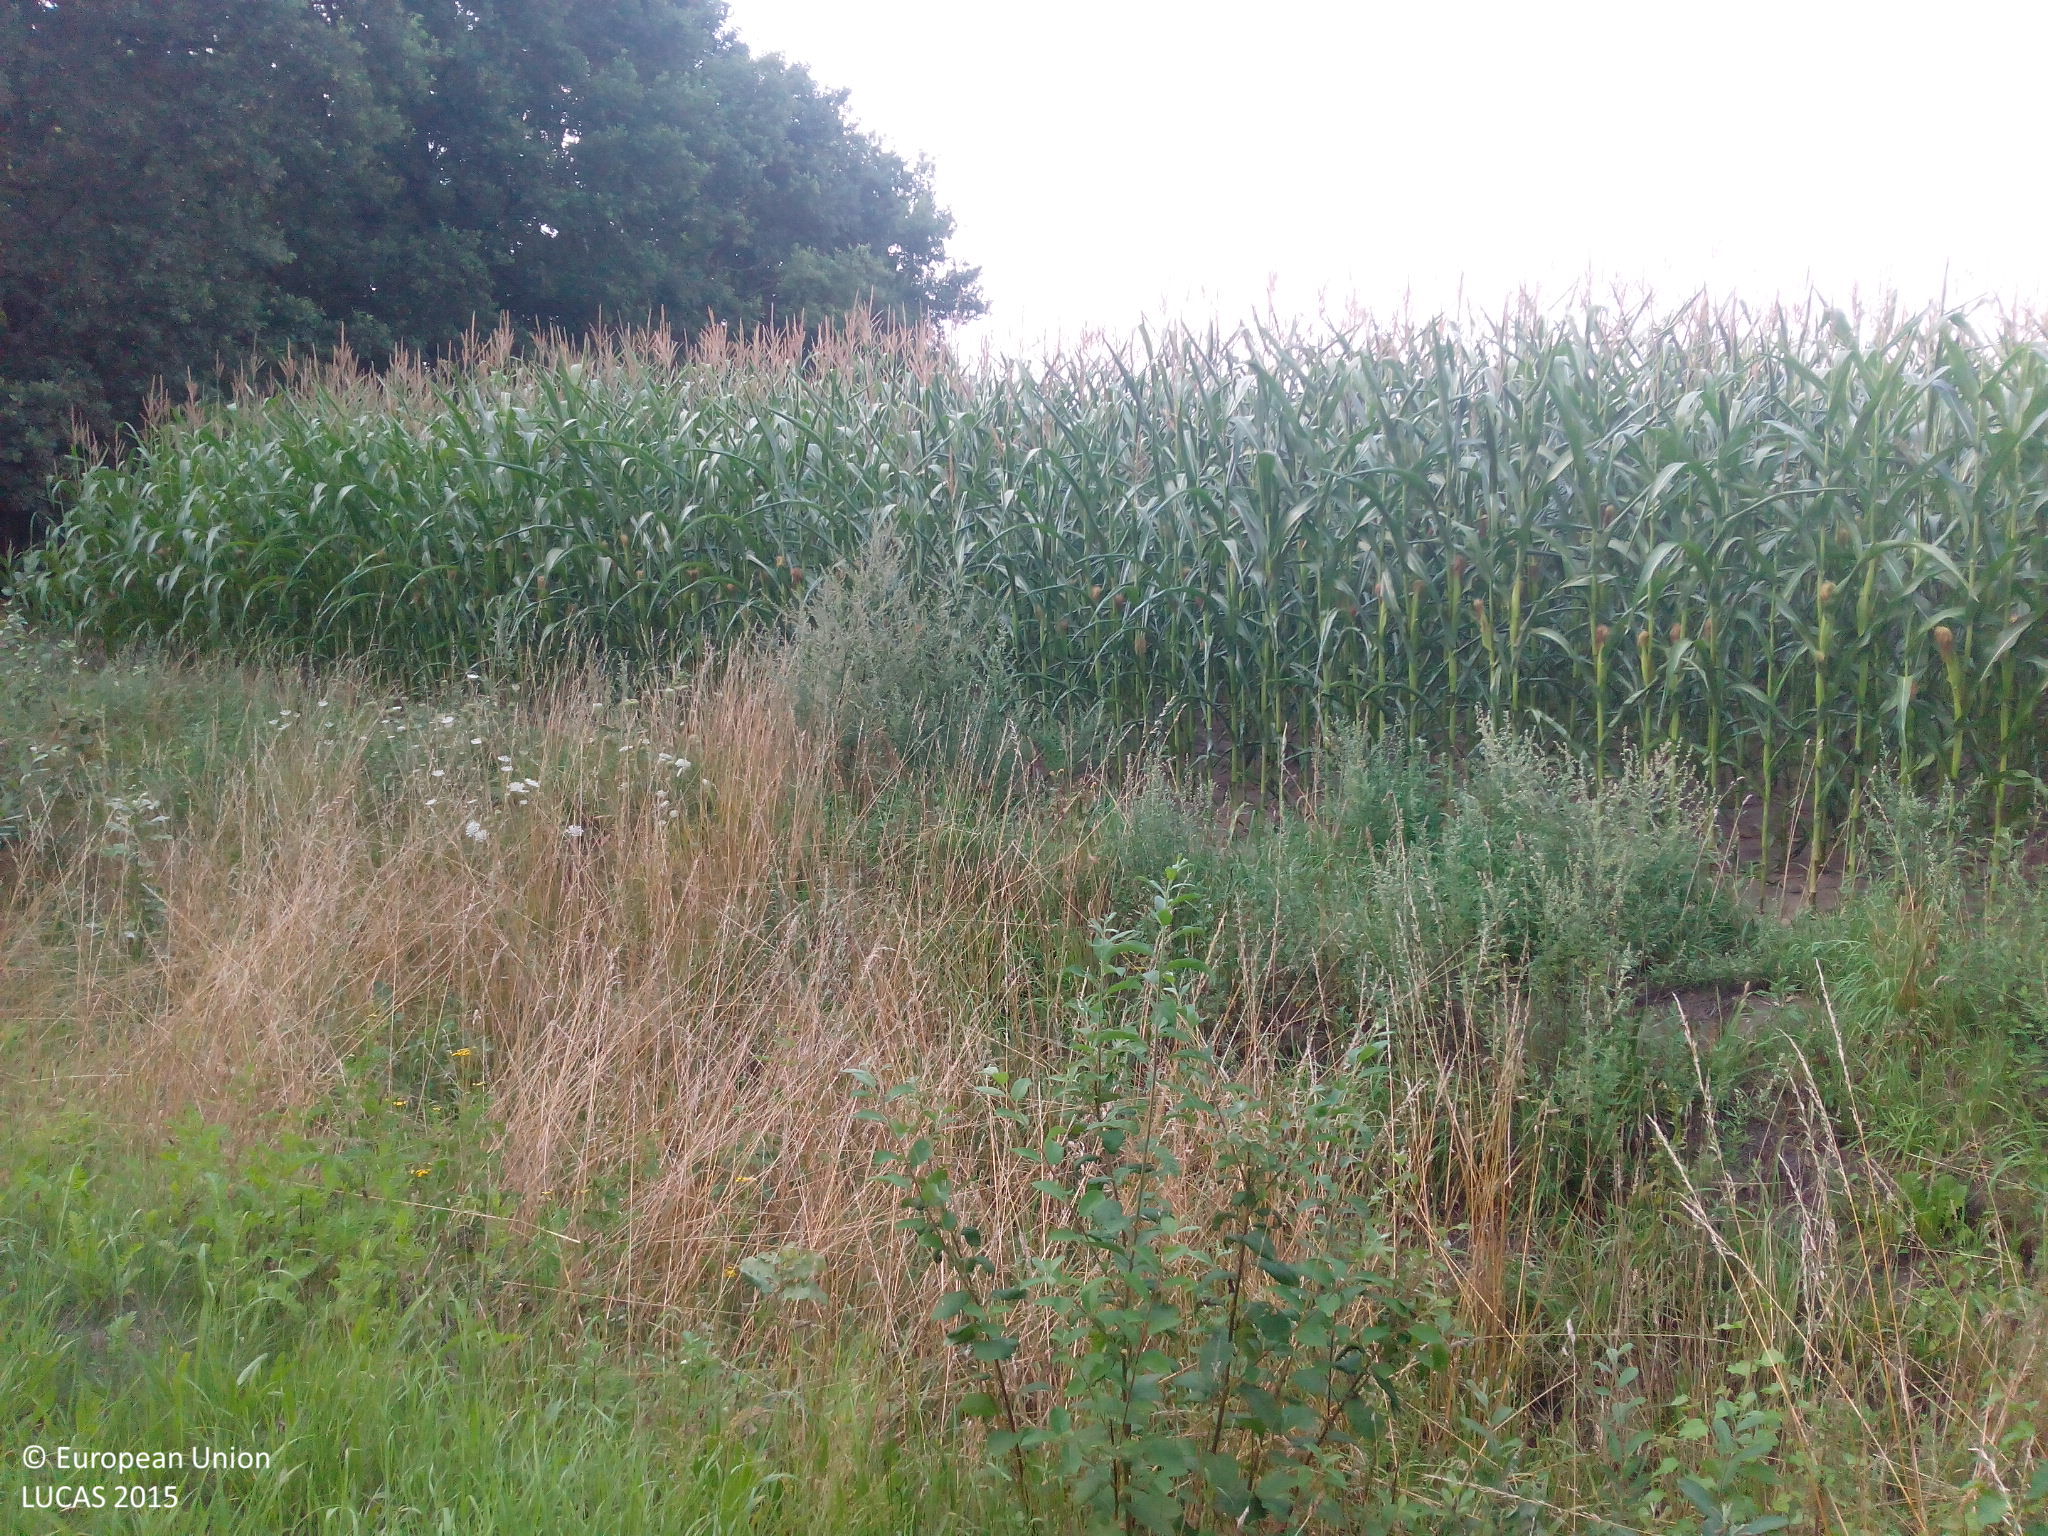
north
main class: Cropland
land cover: Maize
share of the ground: > 75 %
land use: Agriculture (excluding fallow land and kitchen gardens)
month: August
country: NL
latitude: 51.7361
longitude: 5.5528
